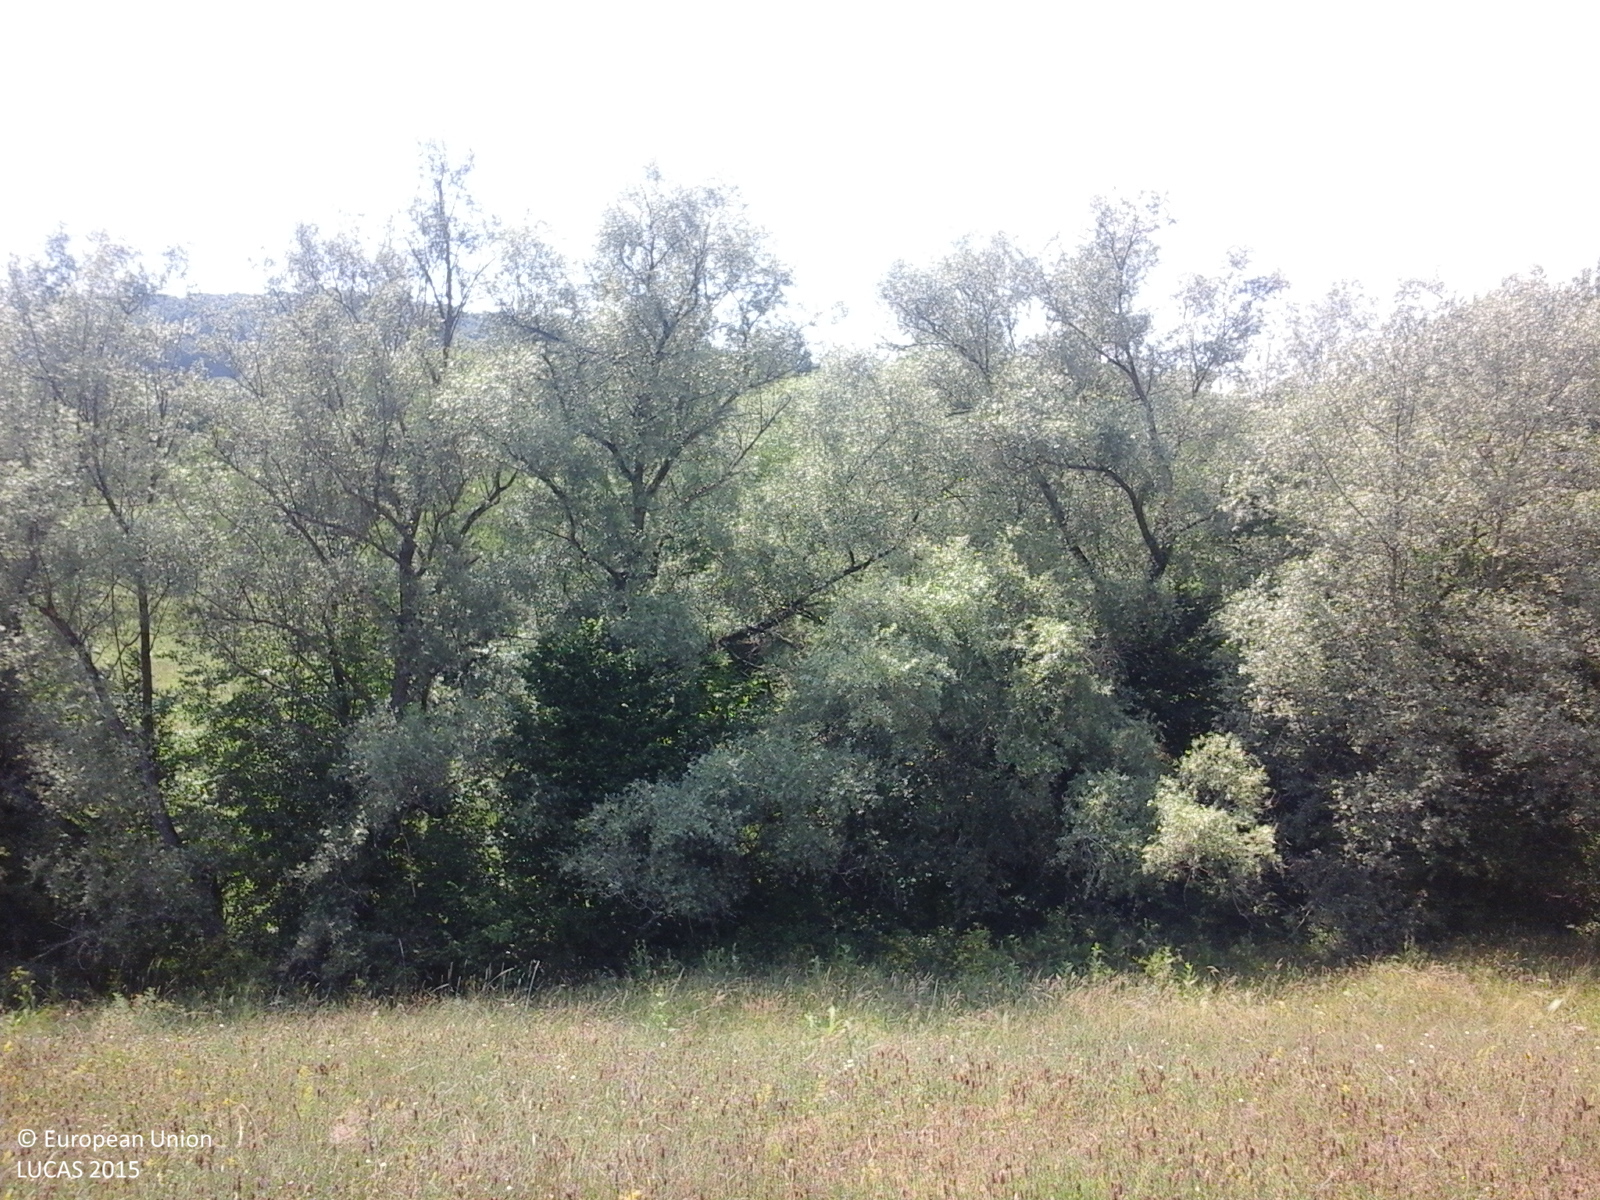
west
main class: Grassland
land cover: Grassland without tree/shrub cover
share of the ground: > 75 %
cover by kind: herbaceous plants 100 %
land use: Agriculture (excluding fallow land and kitchen gardens)
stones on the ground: < 10 %
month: July
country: RO
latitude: 45.1572
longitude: 24.6188
